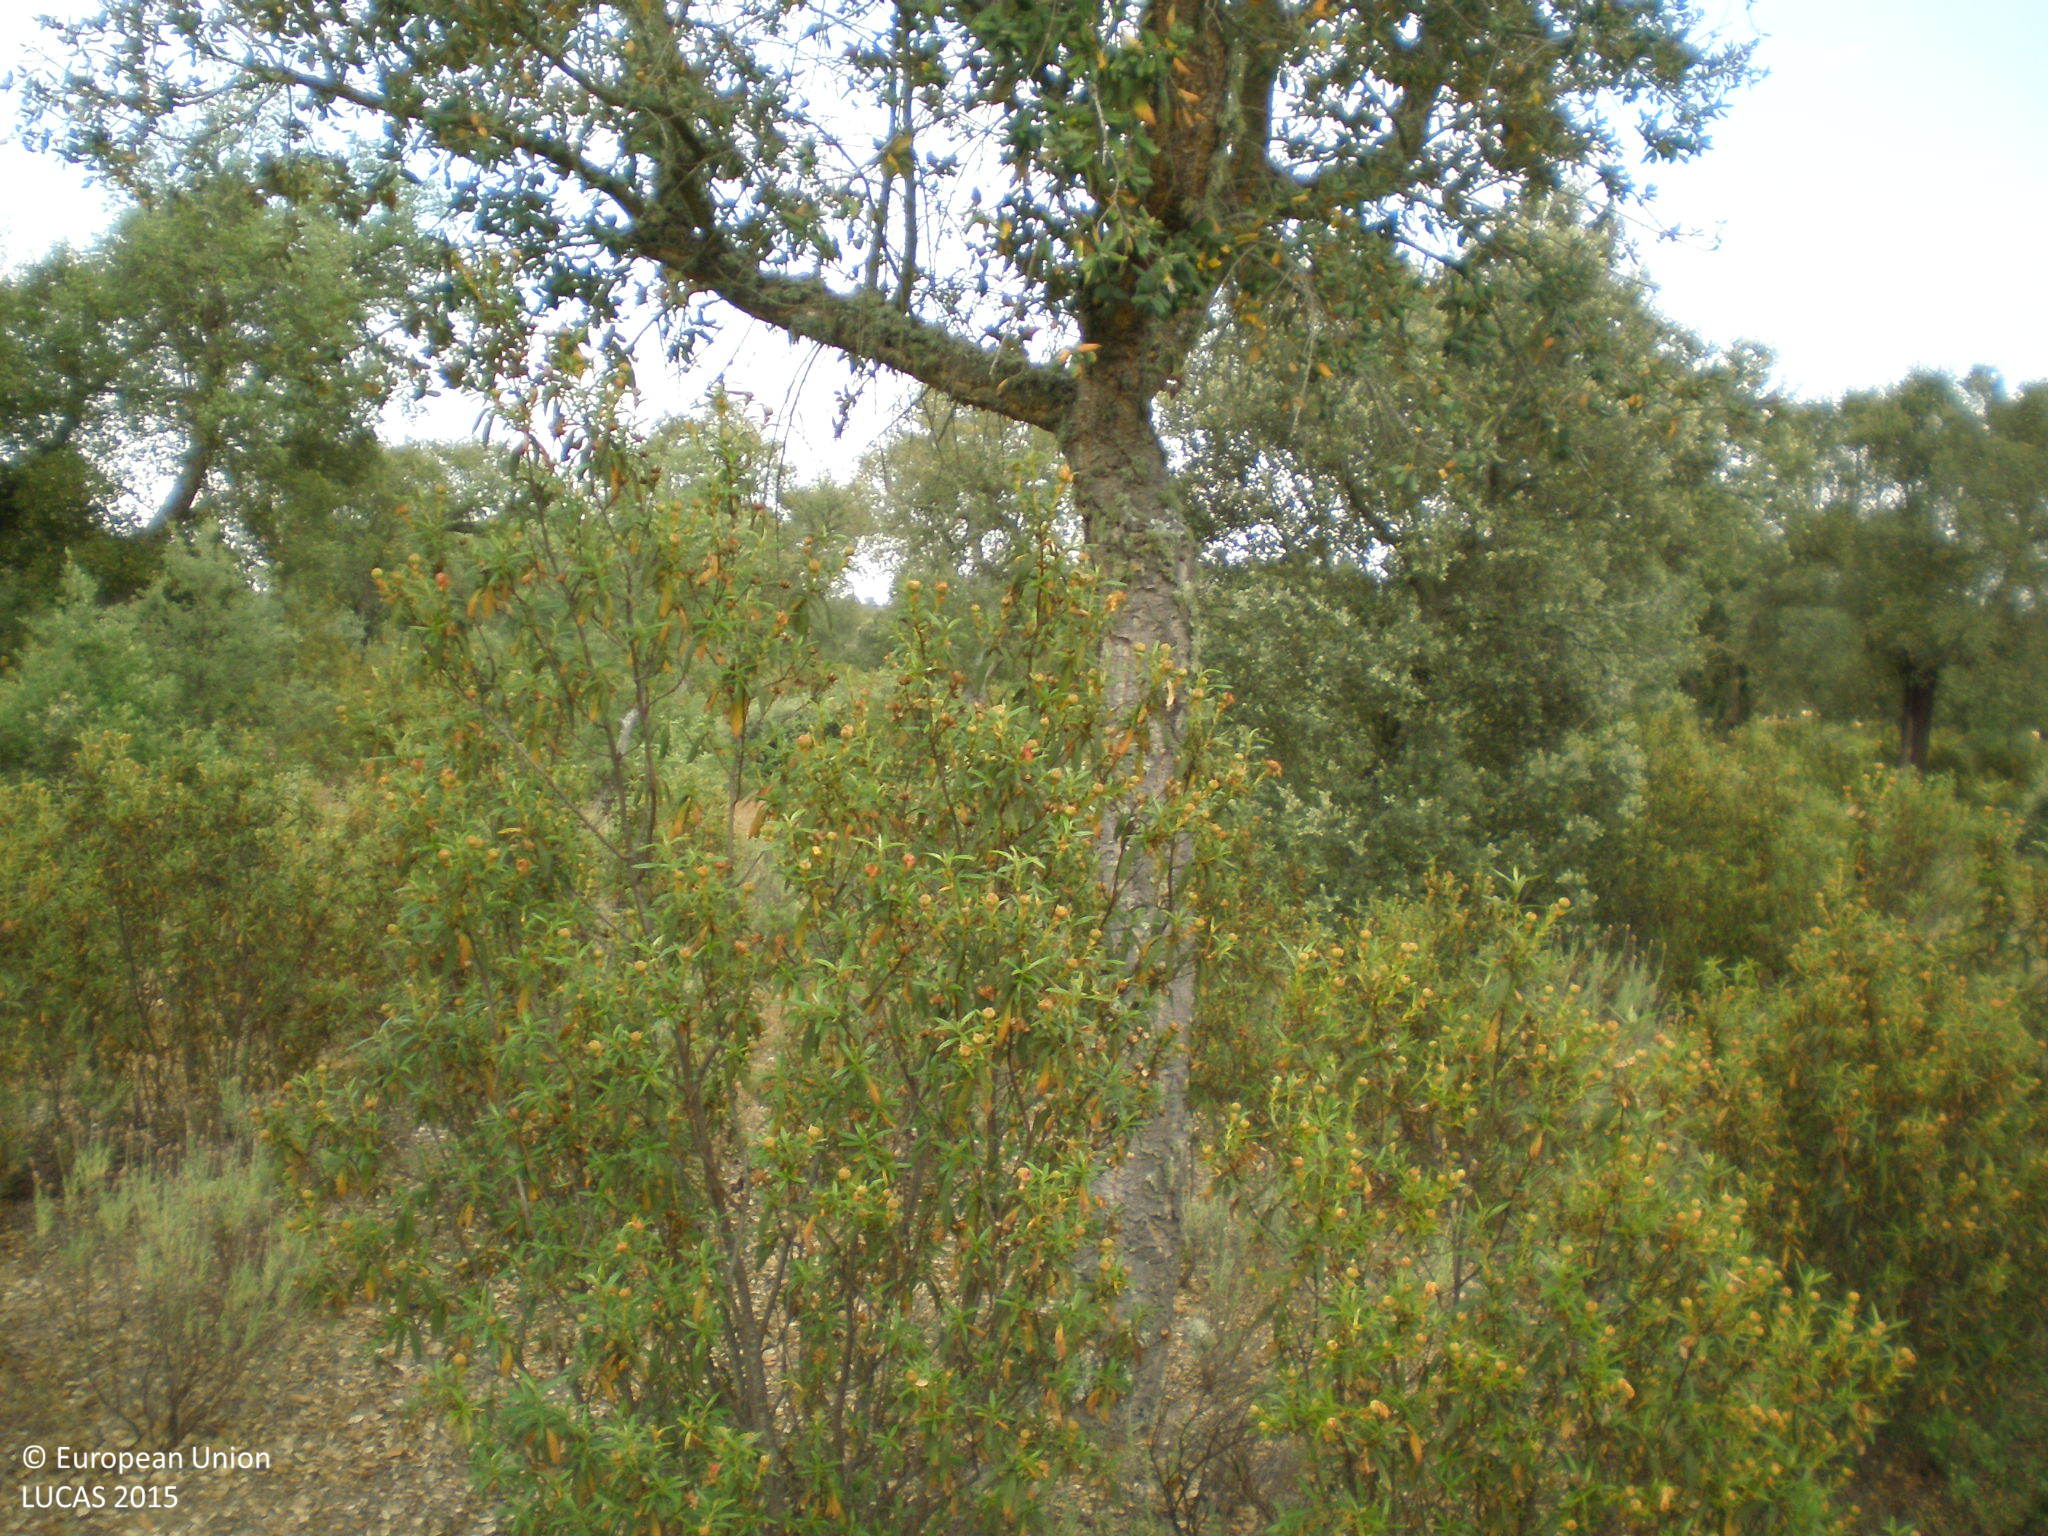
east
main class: Woodland
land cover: Broadleaved woodland
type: broadleaved evergreen forest
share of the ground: 25 - 50 %
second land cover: Grassland without tree/shrub cover
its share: 50 - 75 %
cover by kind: herbaceous plants 60 %, broadleaved forest trees 40 %
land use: Forestry
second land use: Agriculture (excluding fallow land and kitchen gardens)
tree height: < 5 m
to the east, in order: Broadleaved woodland; Grassland without tree/shrub cover; Tracks; Broadleaved woodland; Spontaneously vegetated surfaces; Vineyards
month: June
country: ES
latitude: 41.1515
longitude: -5.7753
